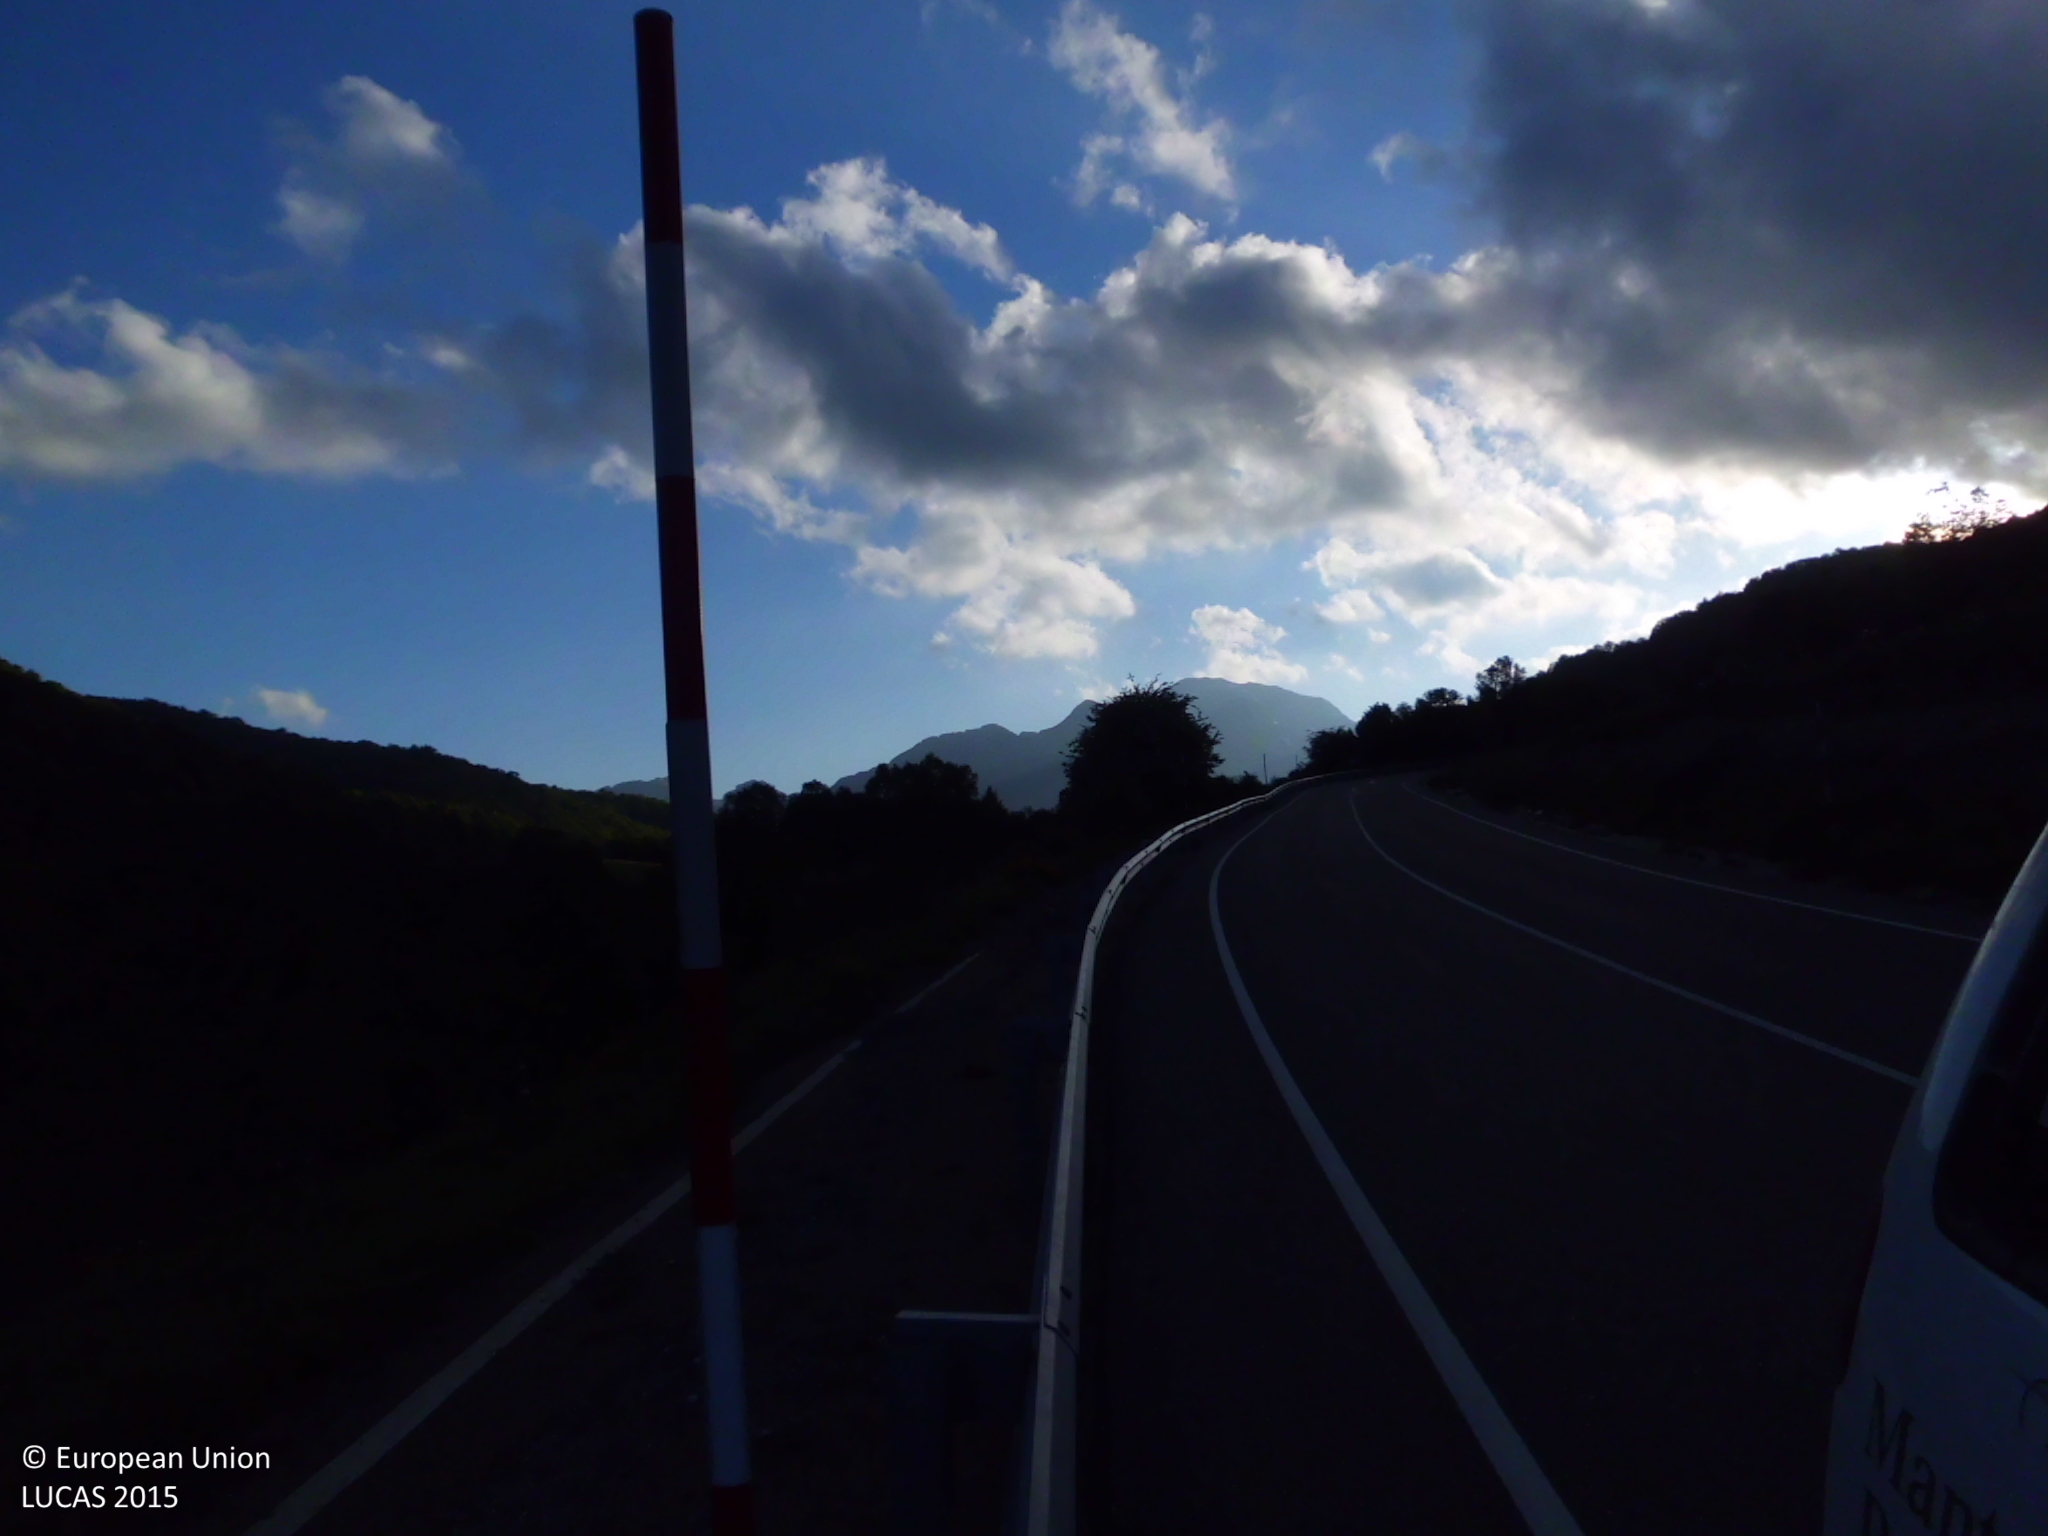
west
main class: Woodland
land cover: Broadleaved woodland
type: acidophilous oak and oak-birch forest
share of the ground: > 75 %
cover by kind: broadleaved forest trees 100 %
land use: Semi-natural and natural areas not in use
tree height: > 5 m
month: May
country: ES
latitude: 43.0639
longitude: -5.1612
